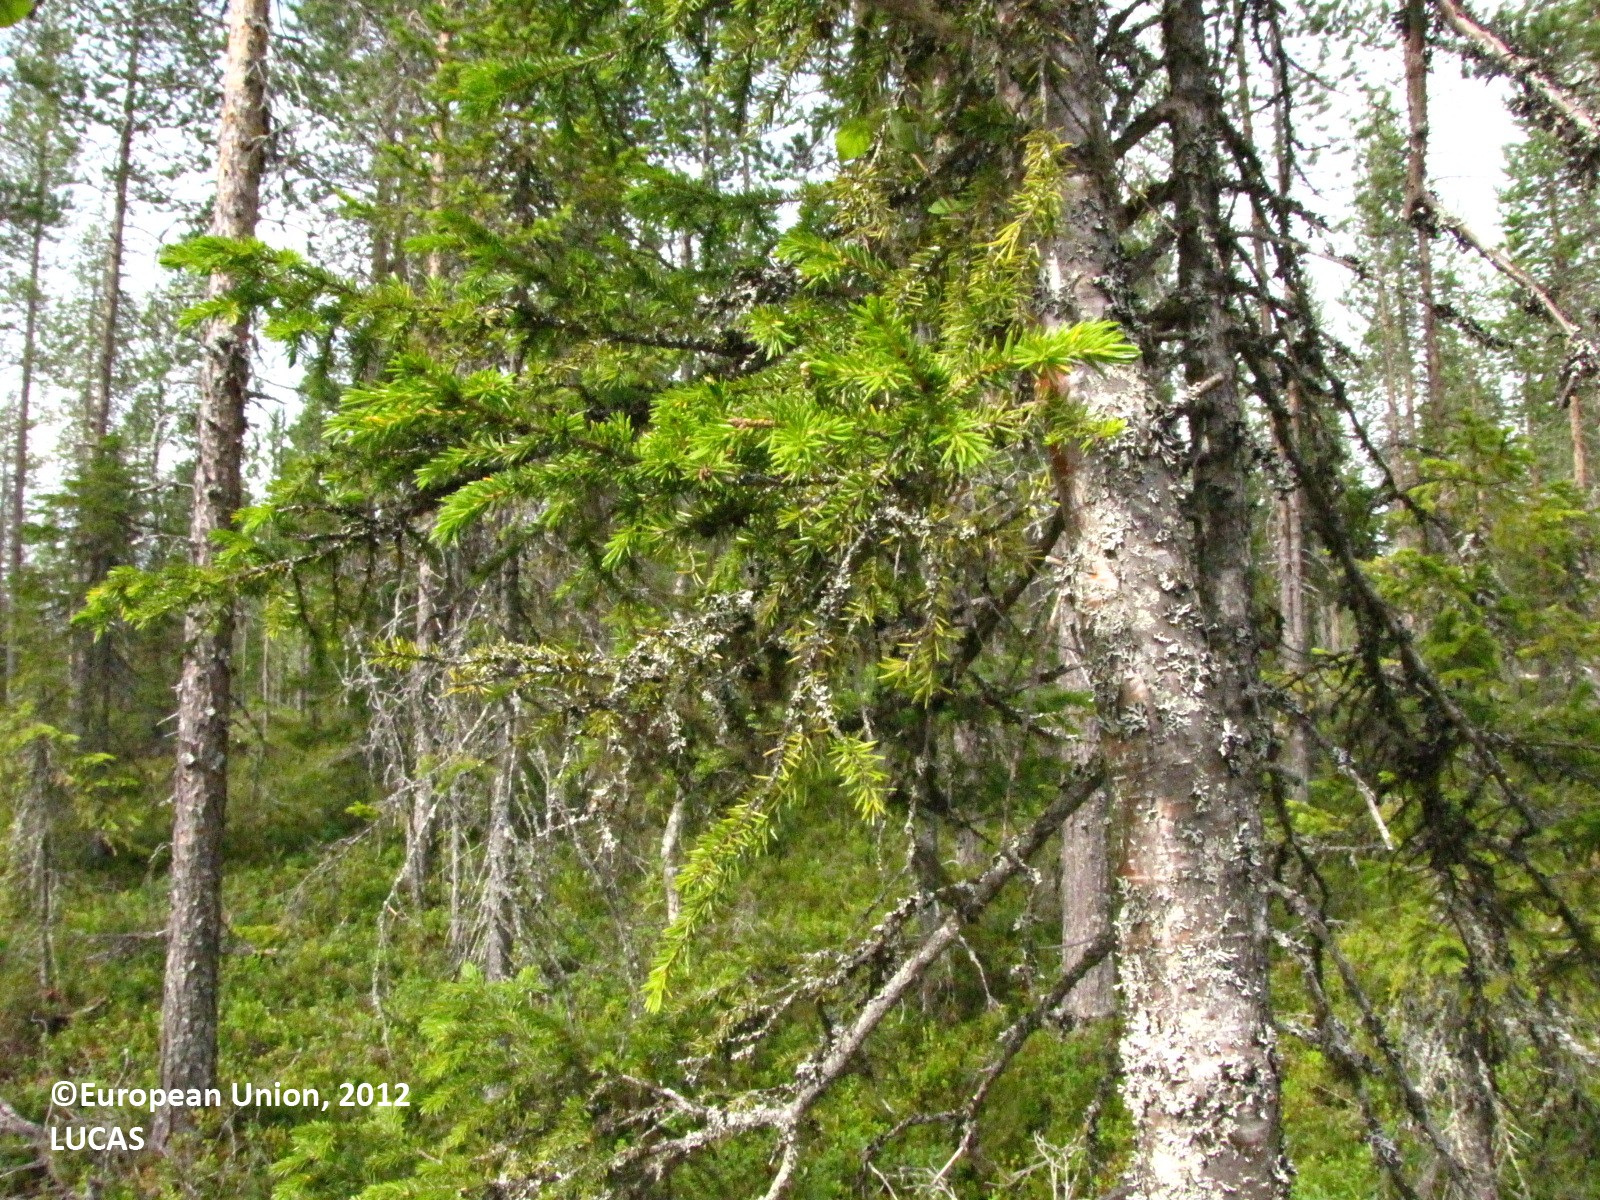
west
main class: Woodland
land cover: Other coniferous woodland
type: boreal forest
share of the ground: 50 - 75 %
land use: Forestry
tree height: > 5 m
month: July
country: FI
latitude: 66.7044
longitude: 25.0759
